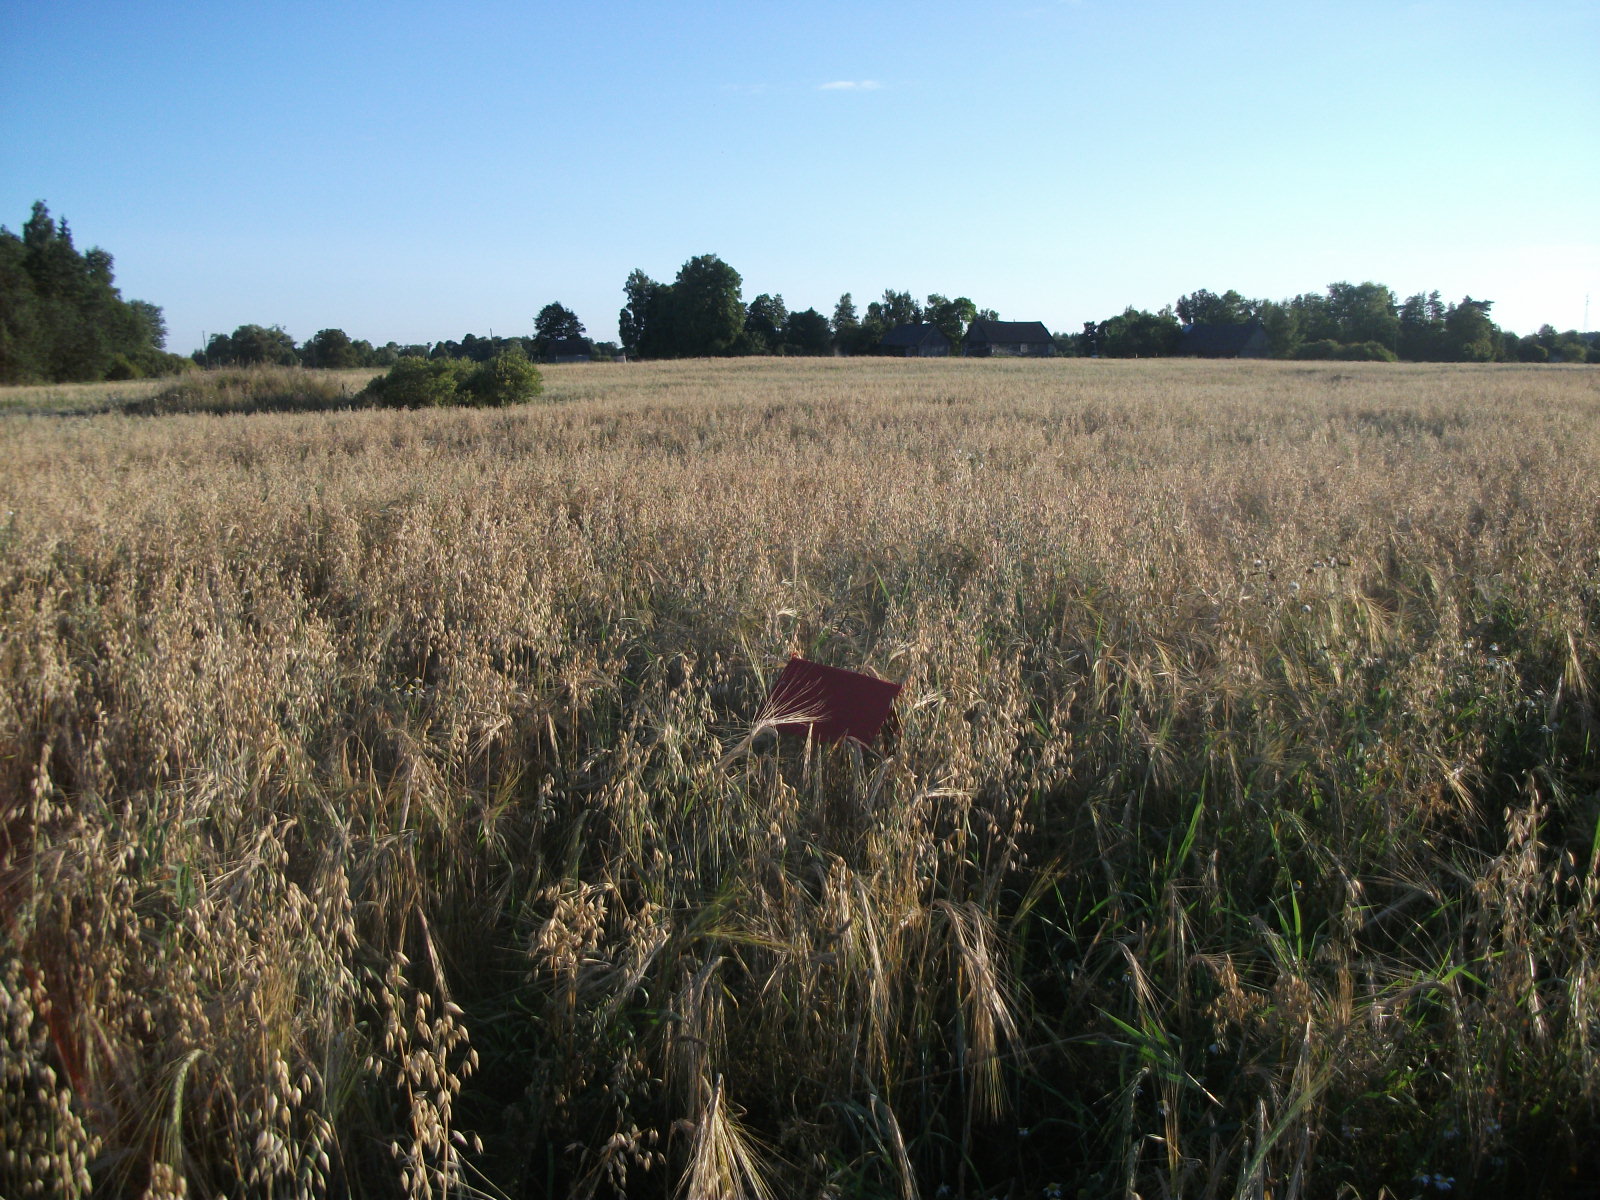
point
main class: Cropland
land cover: Mixed cereals for fodder
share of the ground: 50 - 75 %
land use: Agriculture (excluding fallow land and kitchen gardens)
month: August
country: LV
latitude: 56.3397
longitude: 26.3704
